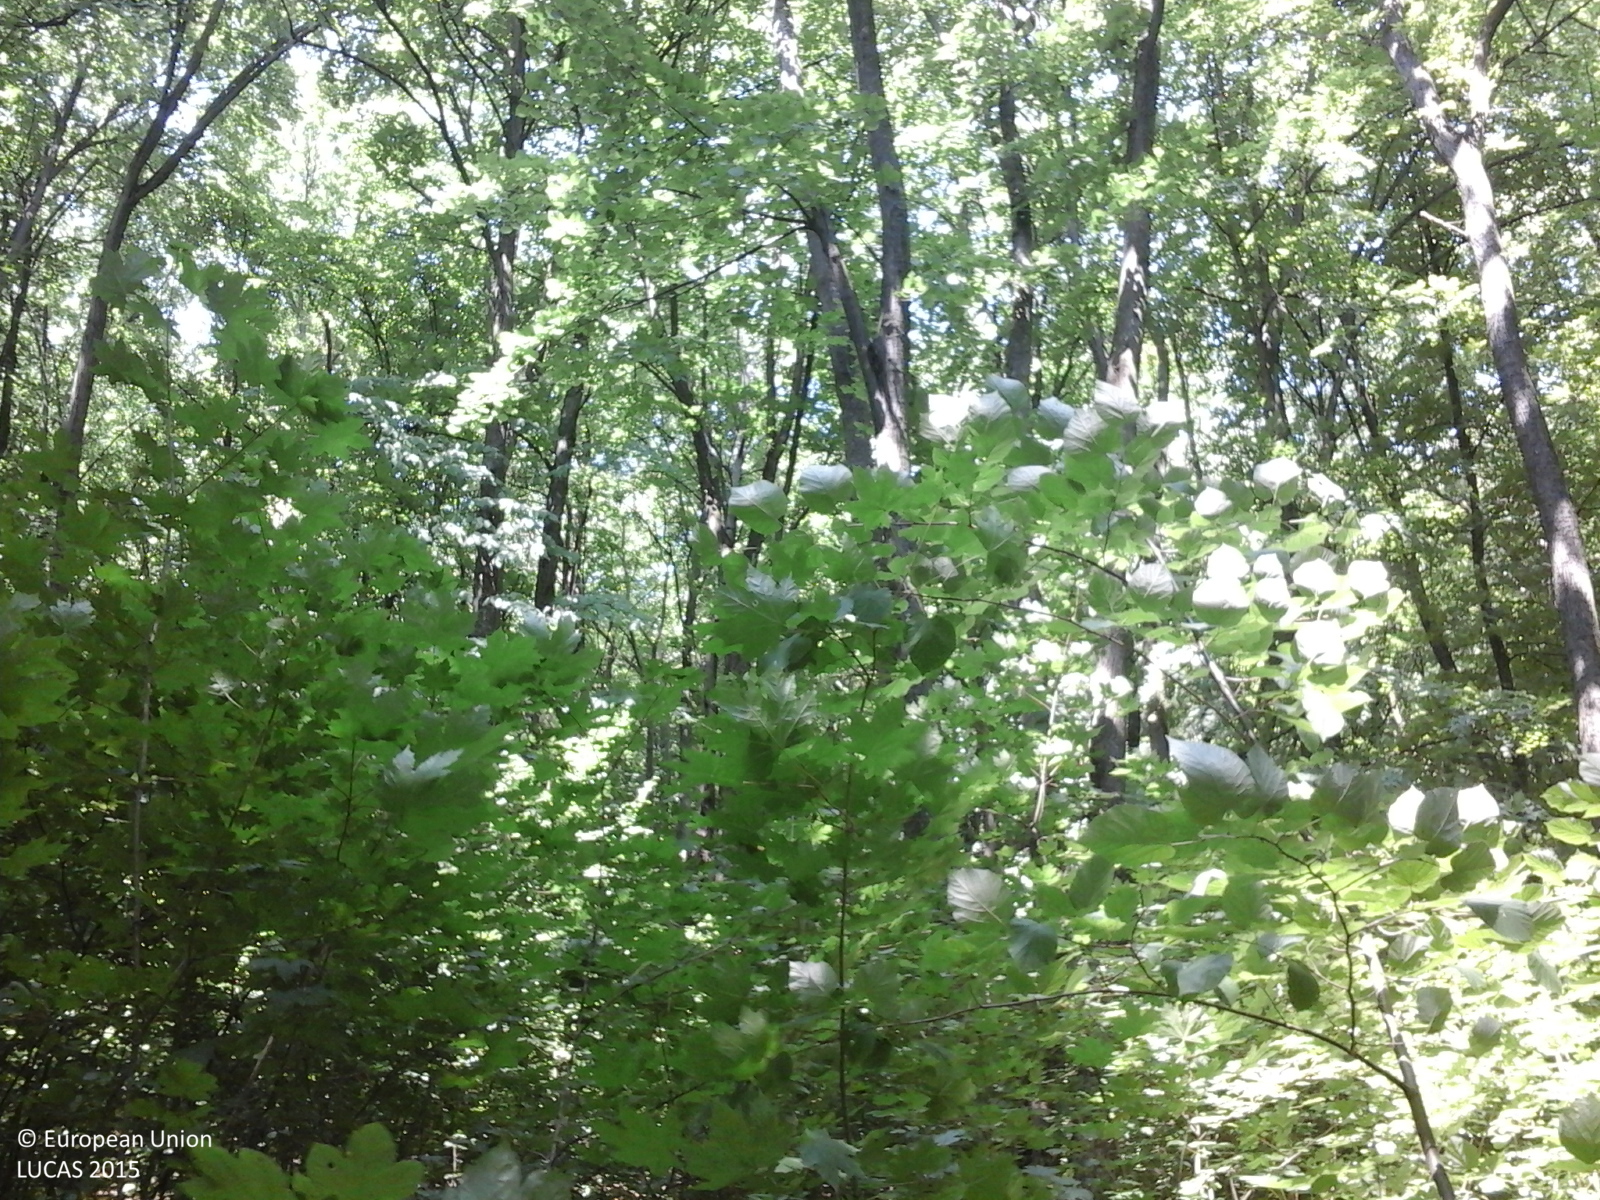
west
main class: Woodland
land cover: Broadleaved woodland
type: beech forest
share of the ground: > 75 %
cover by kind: broadleaved forest trees 90 %, shrubs 5 %, herbaceous plants 5 %
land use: Forestry
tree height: > 5 m
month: June
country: RO
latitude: 46.8204
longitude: 27.3176
